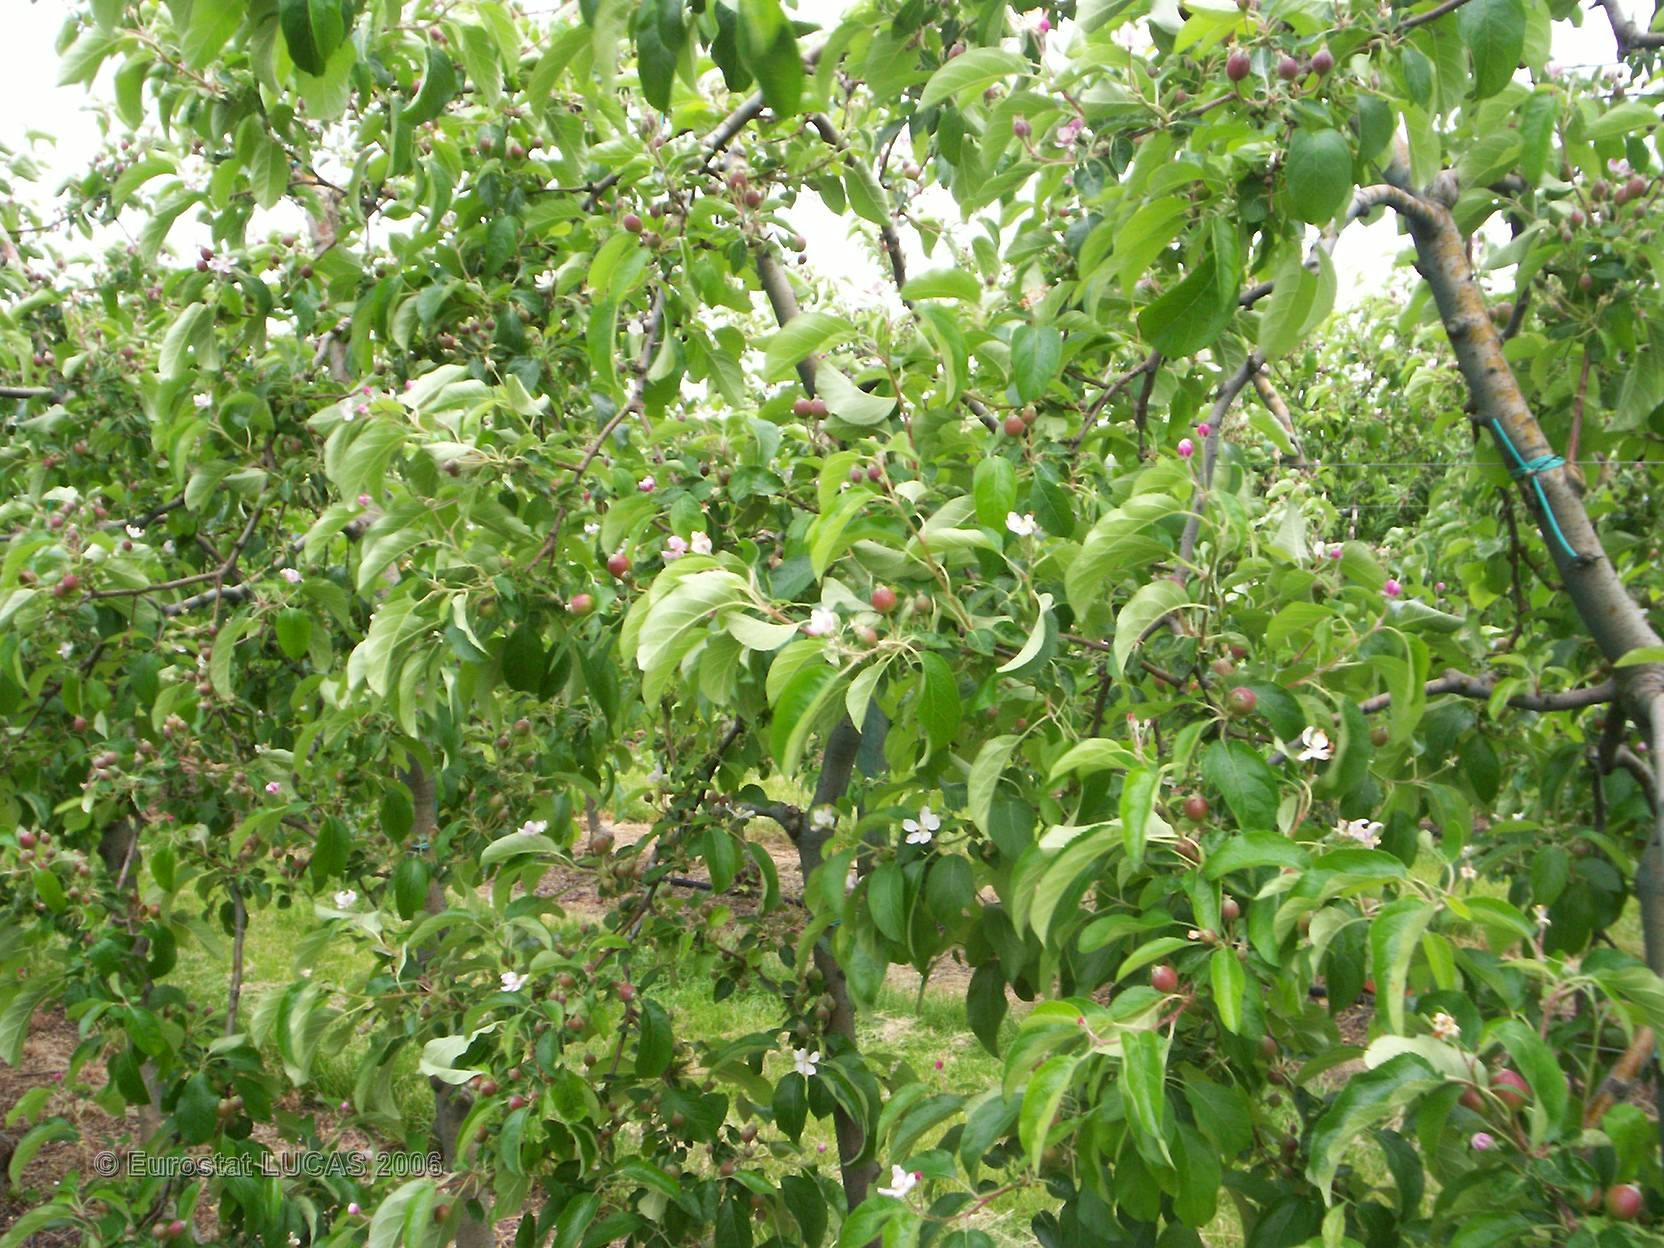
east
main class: Cropland
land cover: Apple fruit
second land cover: Grassland with sparse tree/shrub cover
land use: Agriculture (excluding fallow land and kitchen gardens)
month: May
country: FR
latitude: 45.8566
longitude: -0.8064
